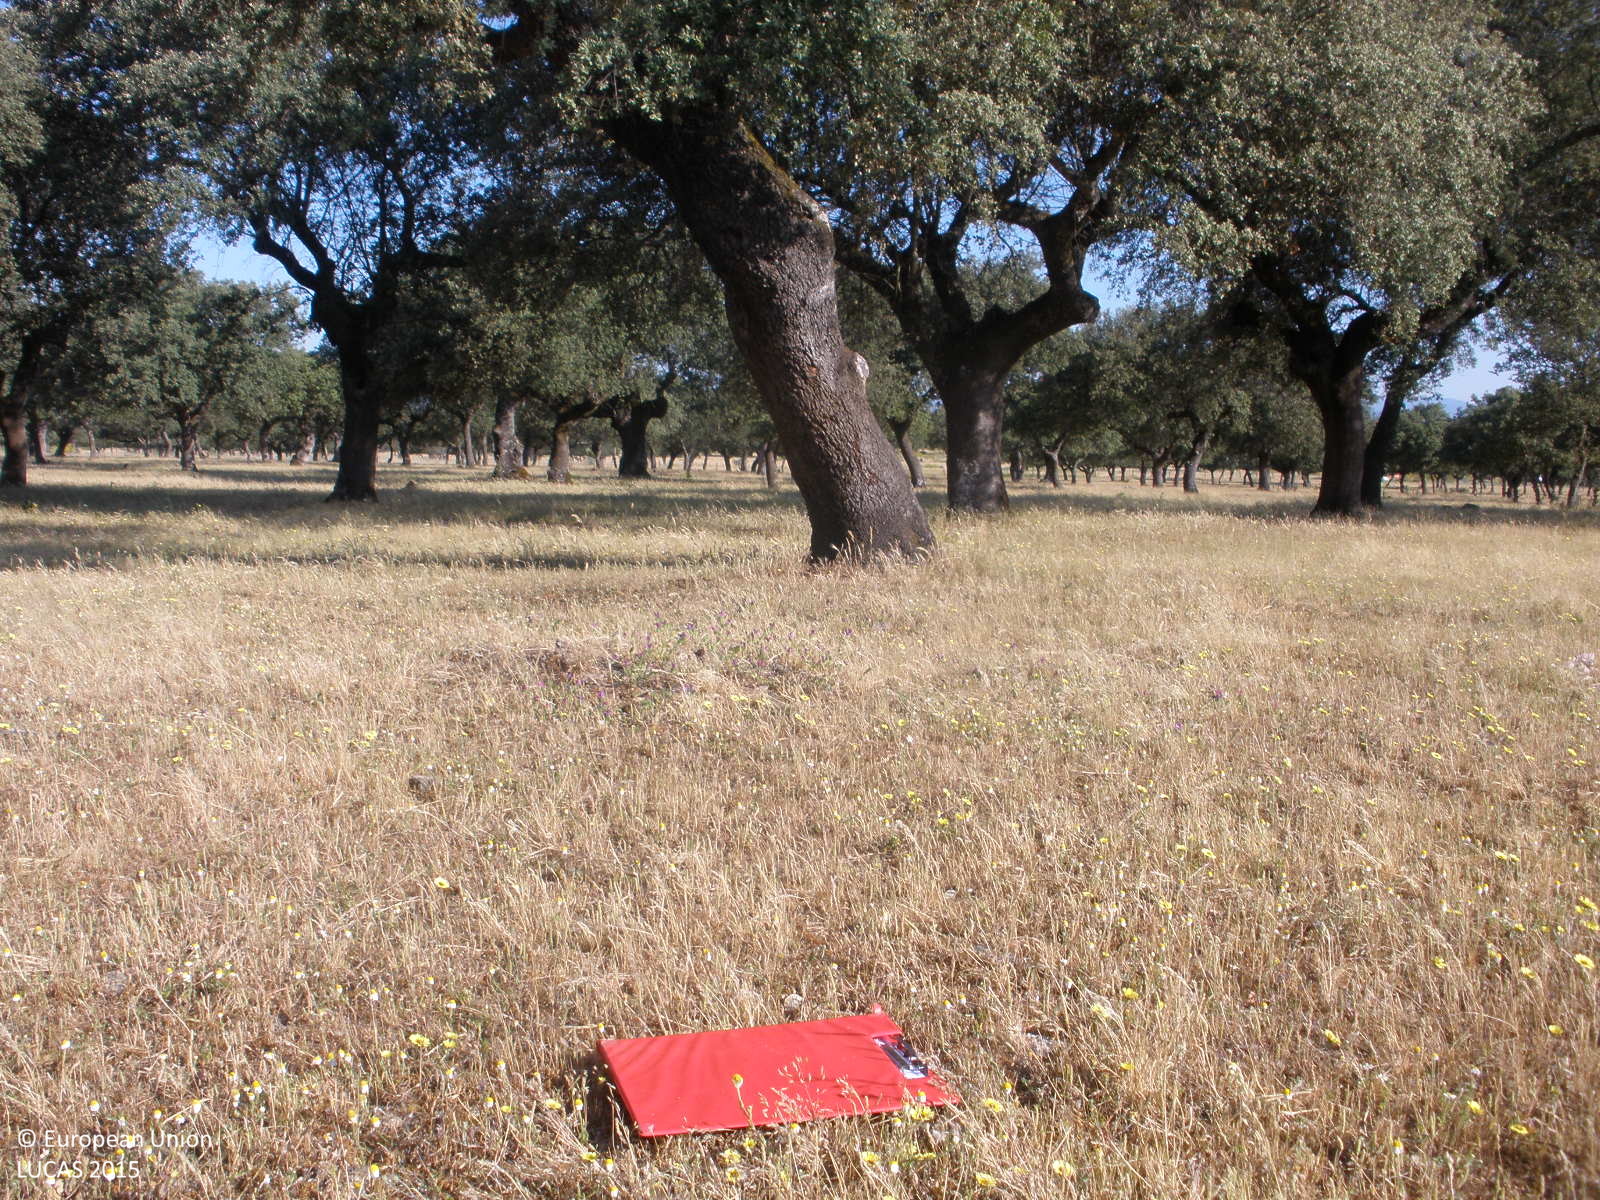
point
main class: Woodland
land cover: Broadleaved woodland
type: broadleaved evergreen forest
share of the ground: 25 - 50 %
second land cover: Grassland without tree/shrub cover
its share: > 75 %
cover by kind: herbaceous plants 70 %, broadleaved forest trees 30 %
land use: Forestry
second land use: Agriculture (excluding fallow land and kitchen gardens)
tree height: > 5 m
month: May
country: ES
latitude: 40.1685
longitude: -6.0541
